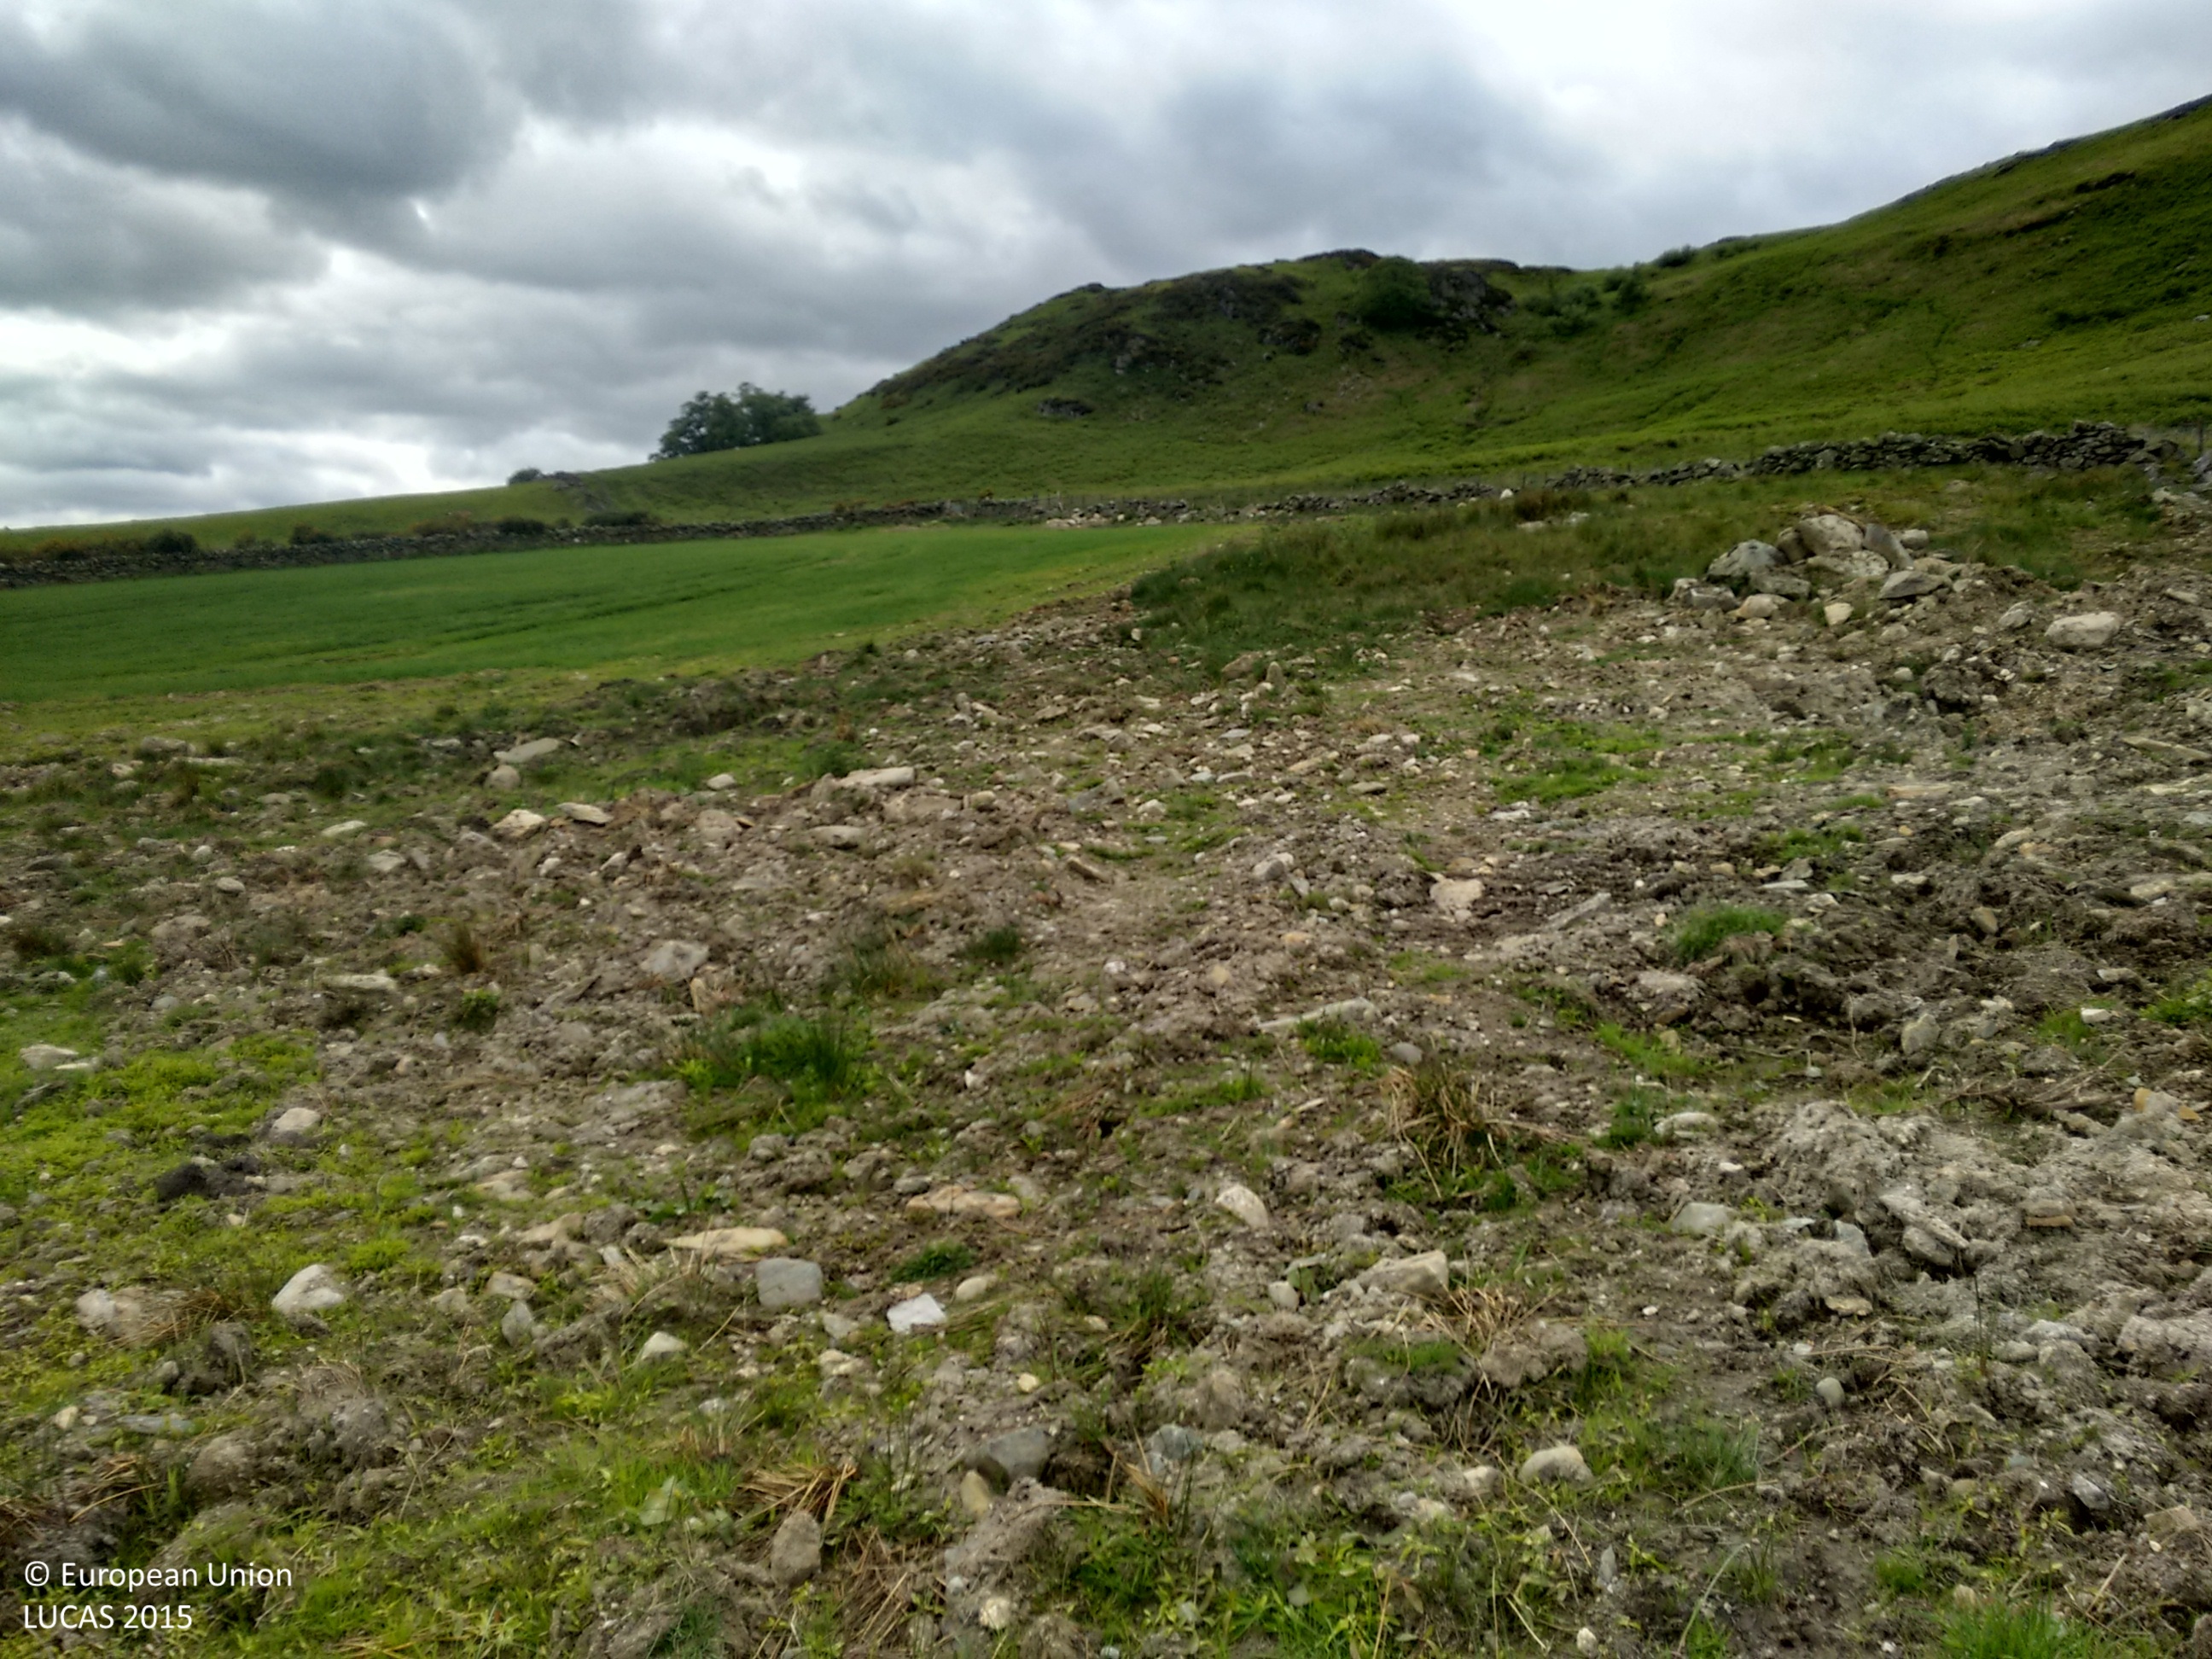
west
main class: Grassland
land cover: Grassland without tree/shrub cover
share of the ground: > 75 %
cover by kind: unconsolidated bare surface 70 %, herbaceous plants 30 %
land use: Agriculture (excluding fallow land and kitchen gardens)
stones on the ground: 25 - 50 %
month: June
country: GB
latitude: 56.5203
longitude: -3.5837
